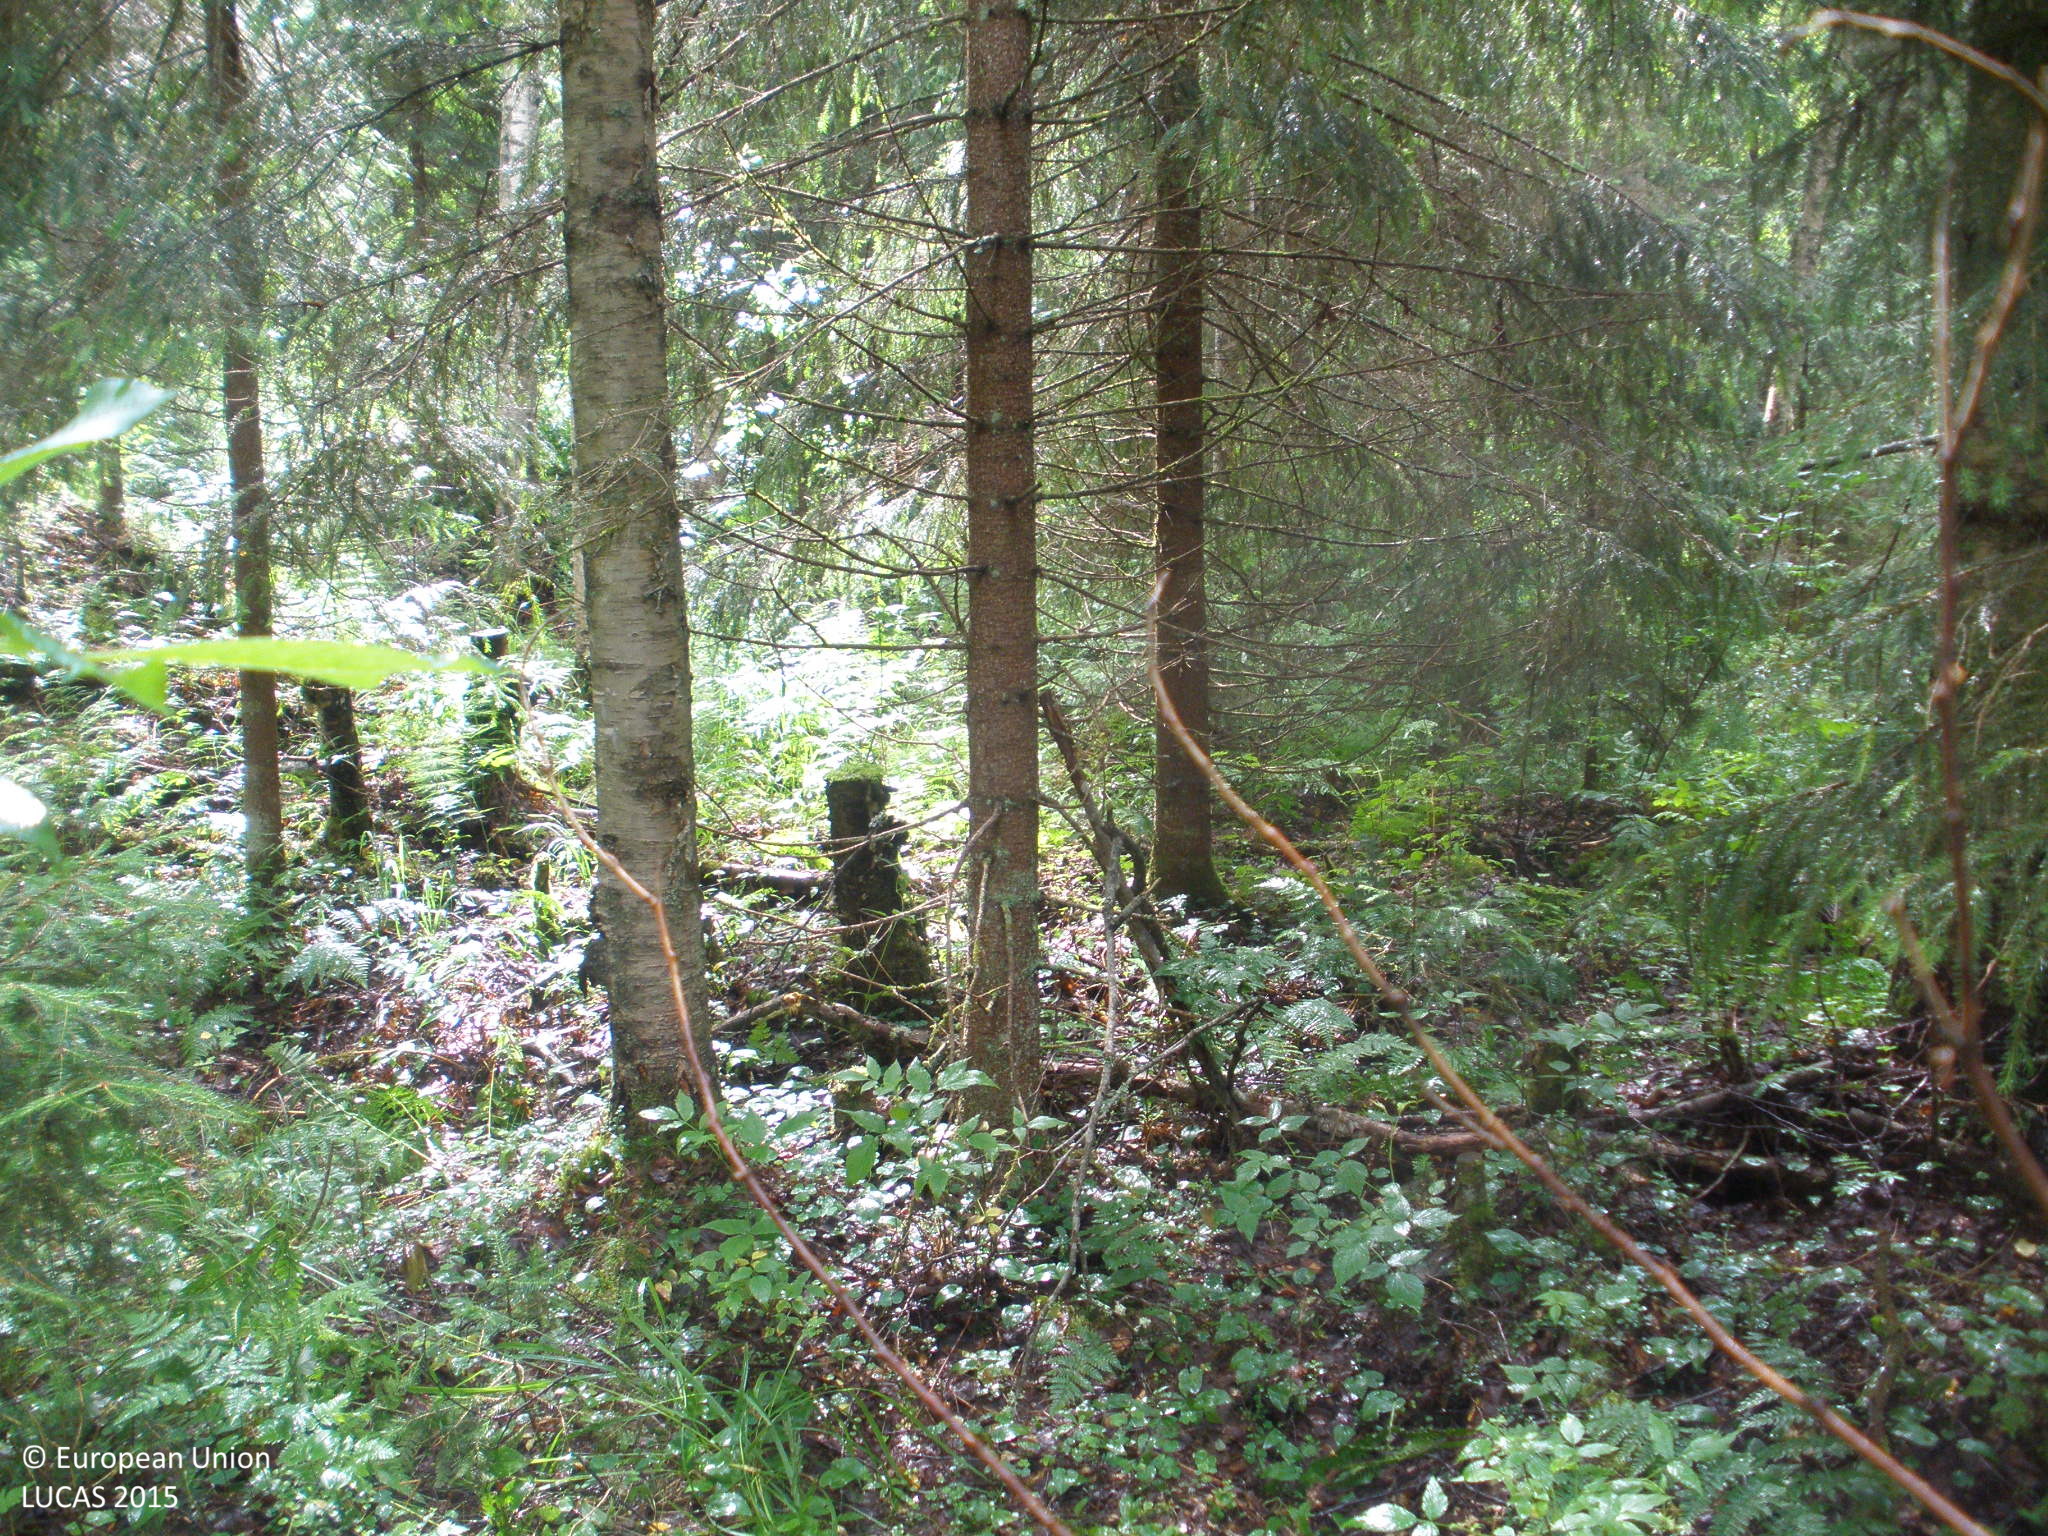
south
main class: Woodland
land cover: Spruce dominated mixed woodland
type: boreal forest
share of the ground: > 75 %
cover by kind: coniferous forest trees 40 %, broadleaved forest trees 40 %, herbaceous plants 10 %, lichens and mosses 10 %
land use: Forestry
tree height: > 5 m
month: July
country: FI
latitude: 61.0191
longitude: 24.8940
